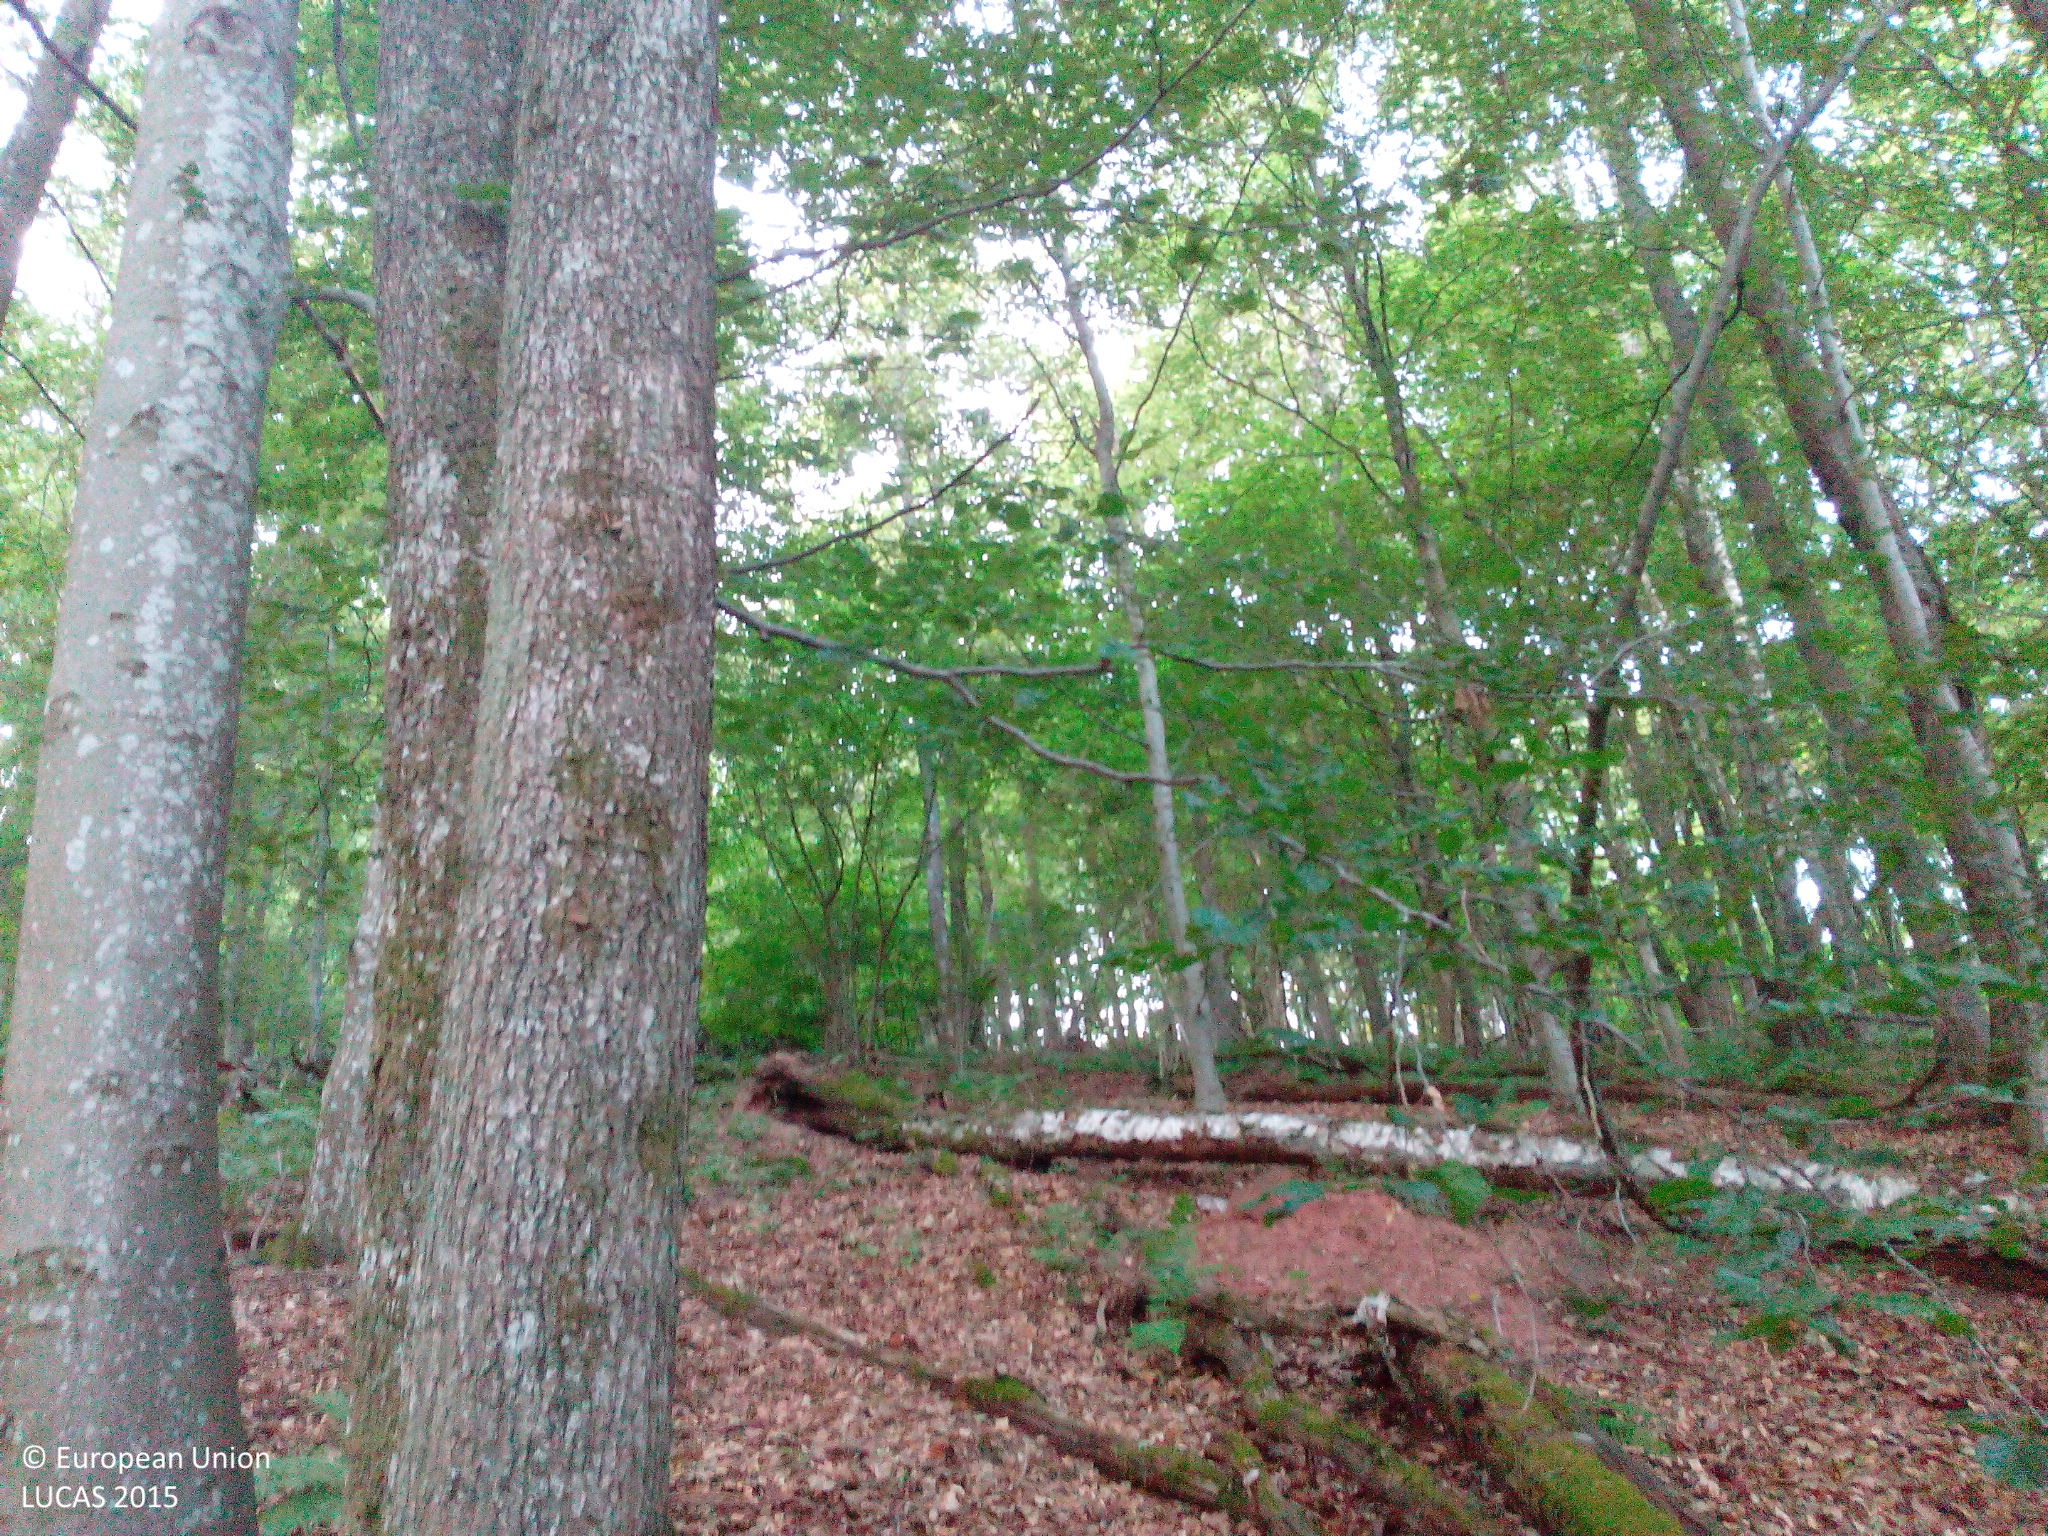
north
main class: Woodland
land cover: Broadleaved woodland
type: beech forest
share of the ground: > 75 %
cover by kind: broadleaved forest trees 90 %, unconsolidated bare surface 10 %
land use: Abandoned areas
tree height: > 5 m
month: July
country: DE
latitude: 49.1329
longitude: 7.5747
